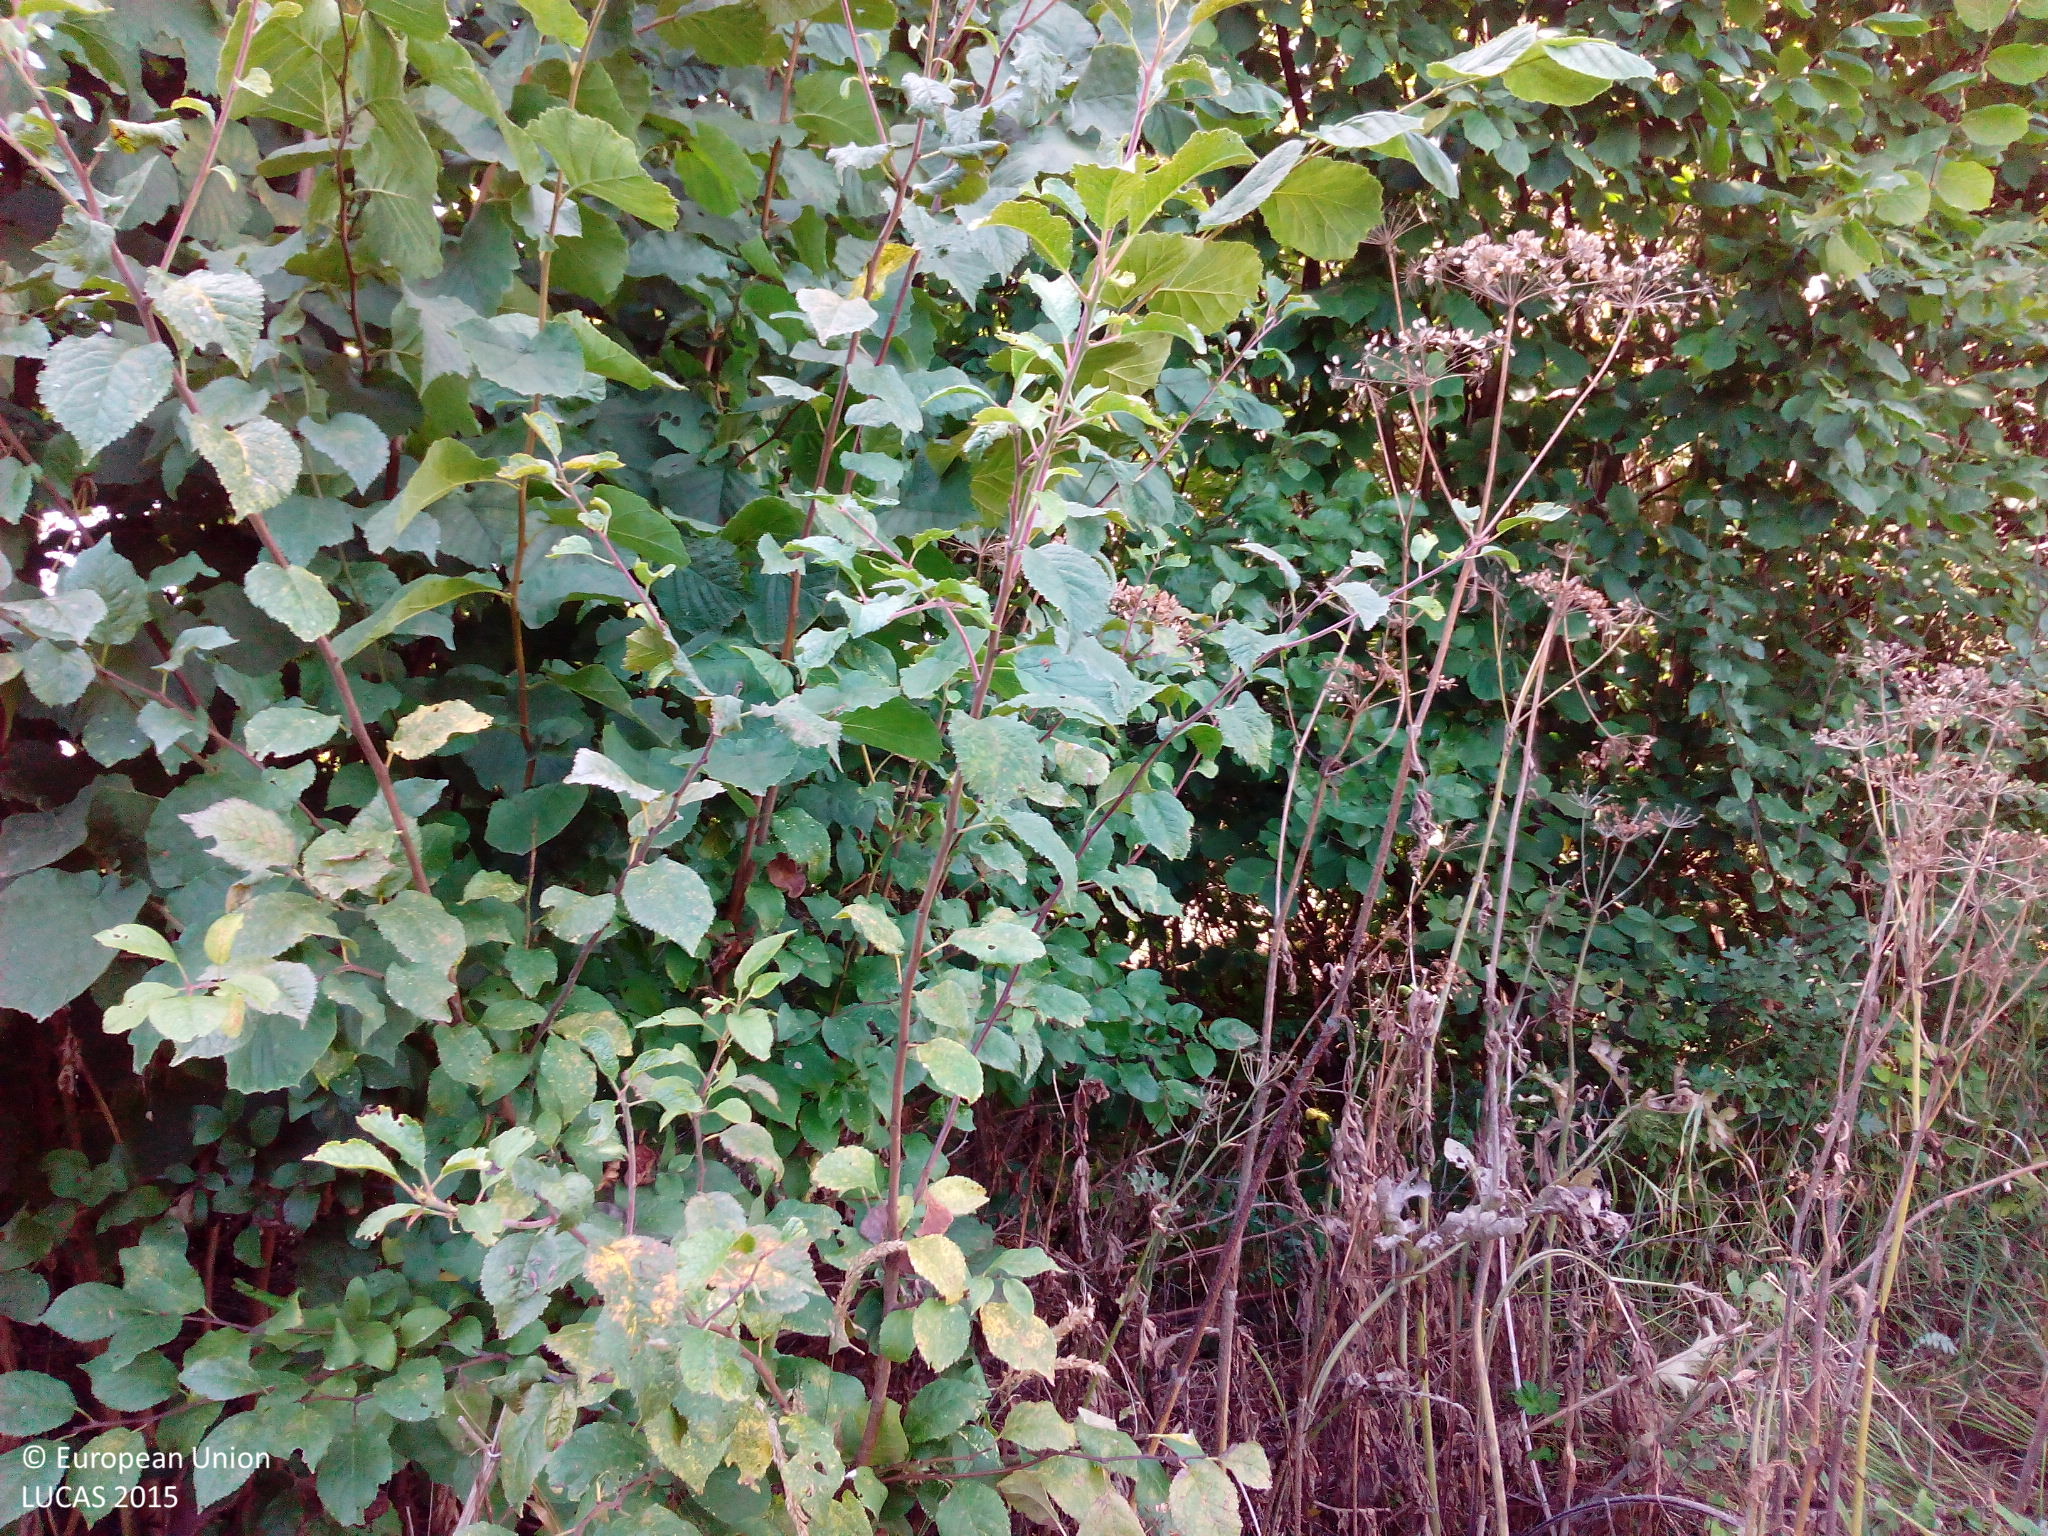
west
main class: Cropland
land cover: Maize
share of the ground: > 75 %
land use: Agriculture (excluding fallow land and kitchen gardens)
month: August
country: DE
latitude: 48.2775
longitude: 9.9327
